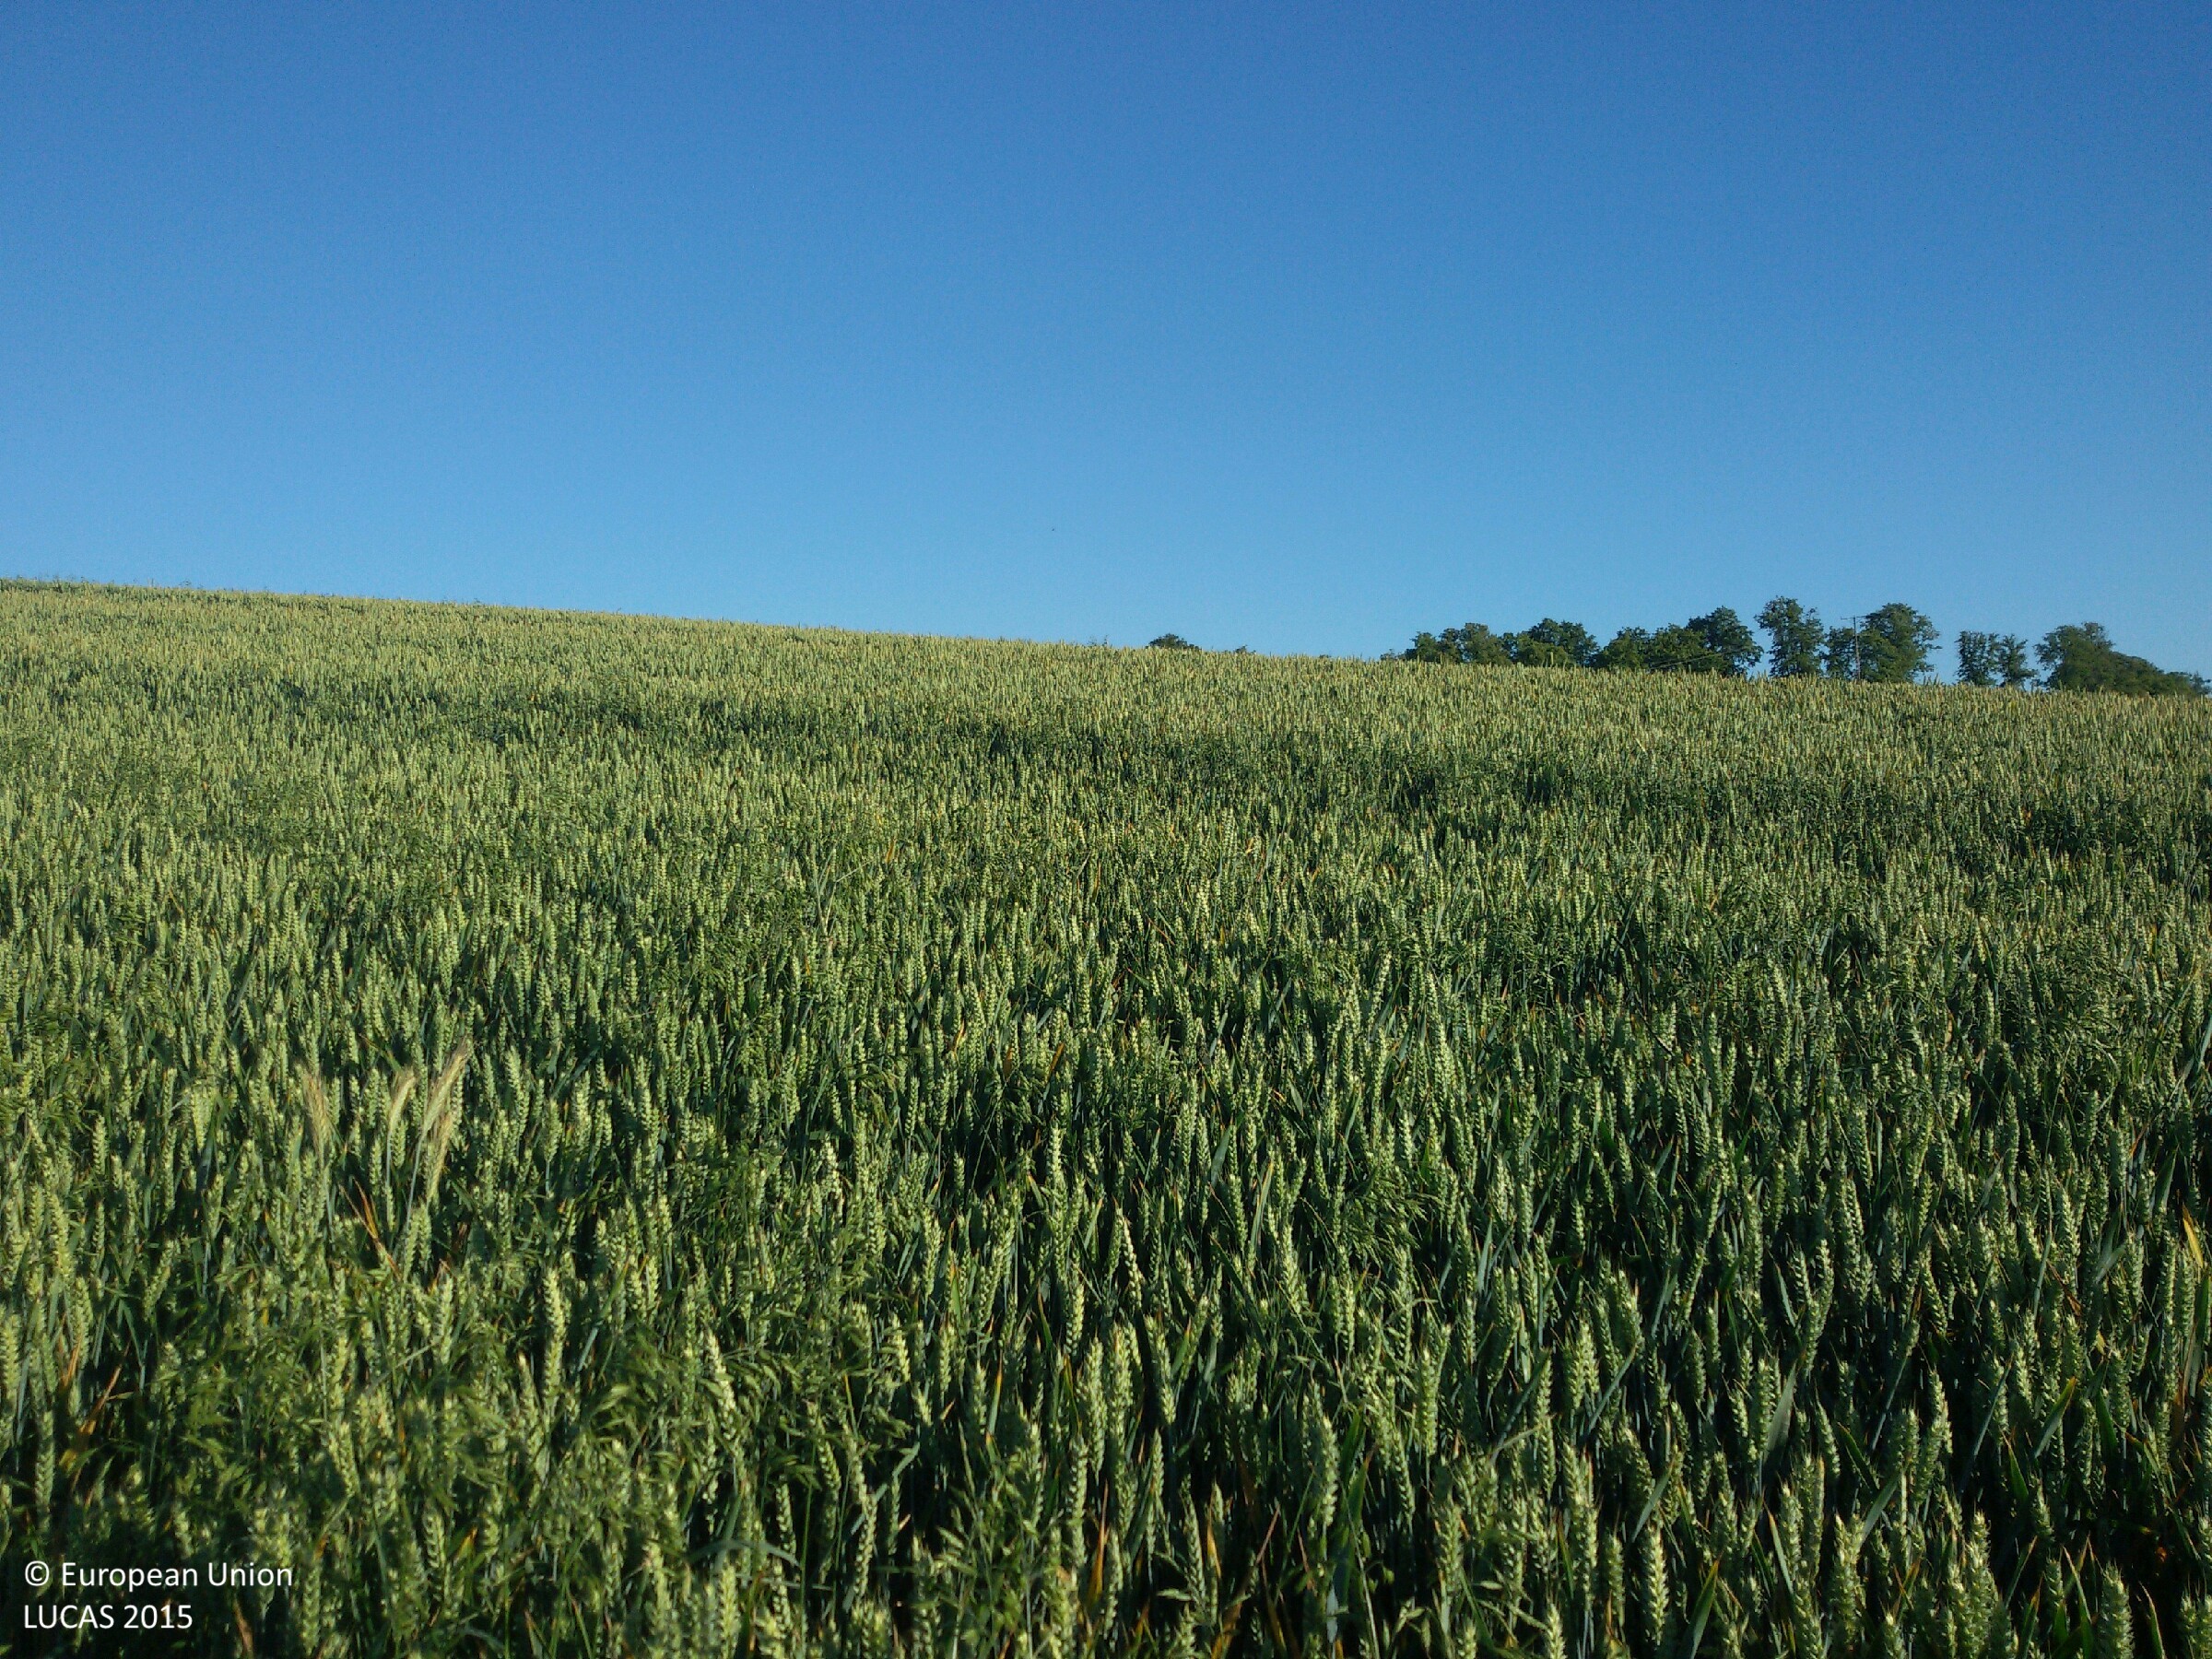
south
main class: Cropland
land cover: Common wheat
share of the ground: > 75 %
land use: Agriculture (excluding fallow land and kitchen gardens)
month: July
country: PL
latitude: 53.8925
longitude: 19.3218
